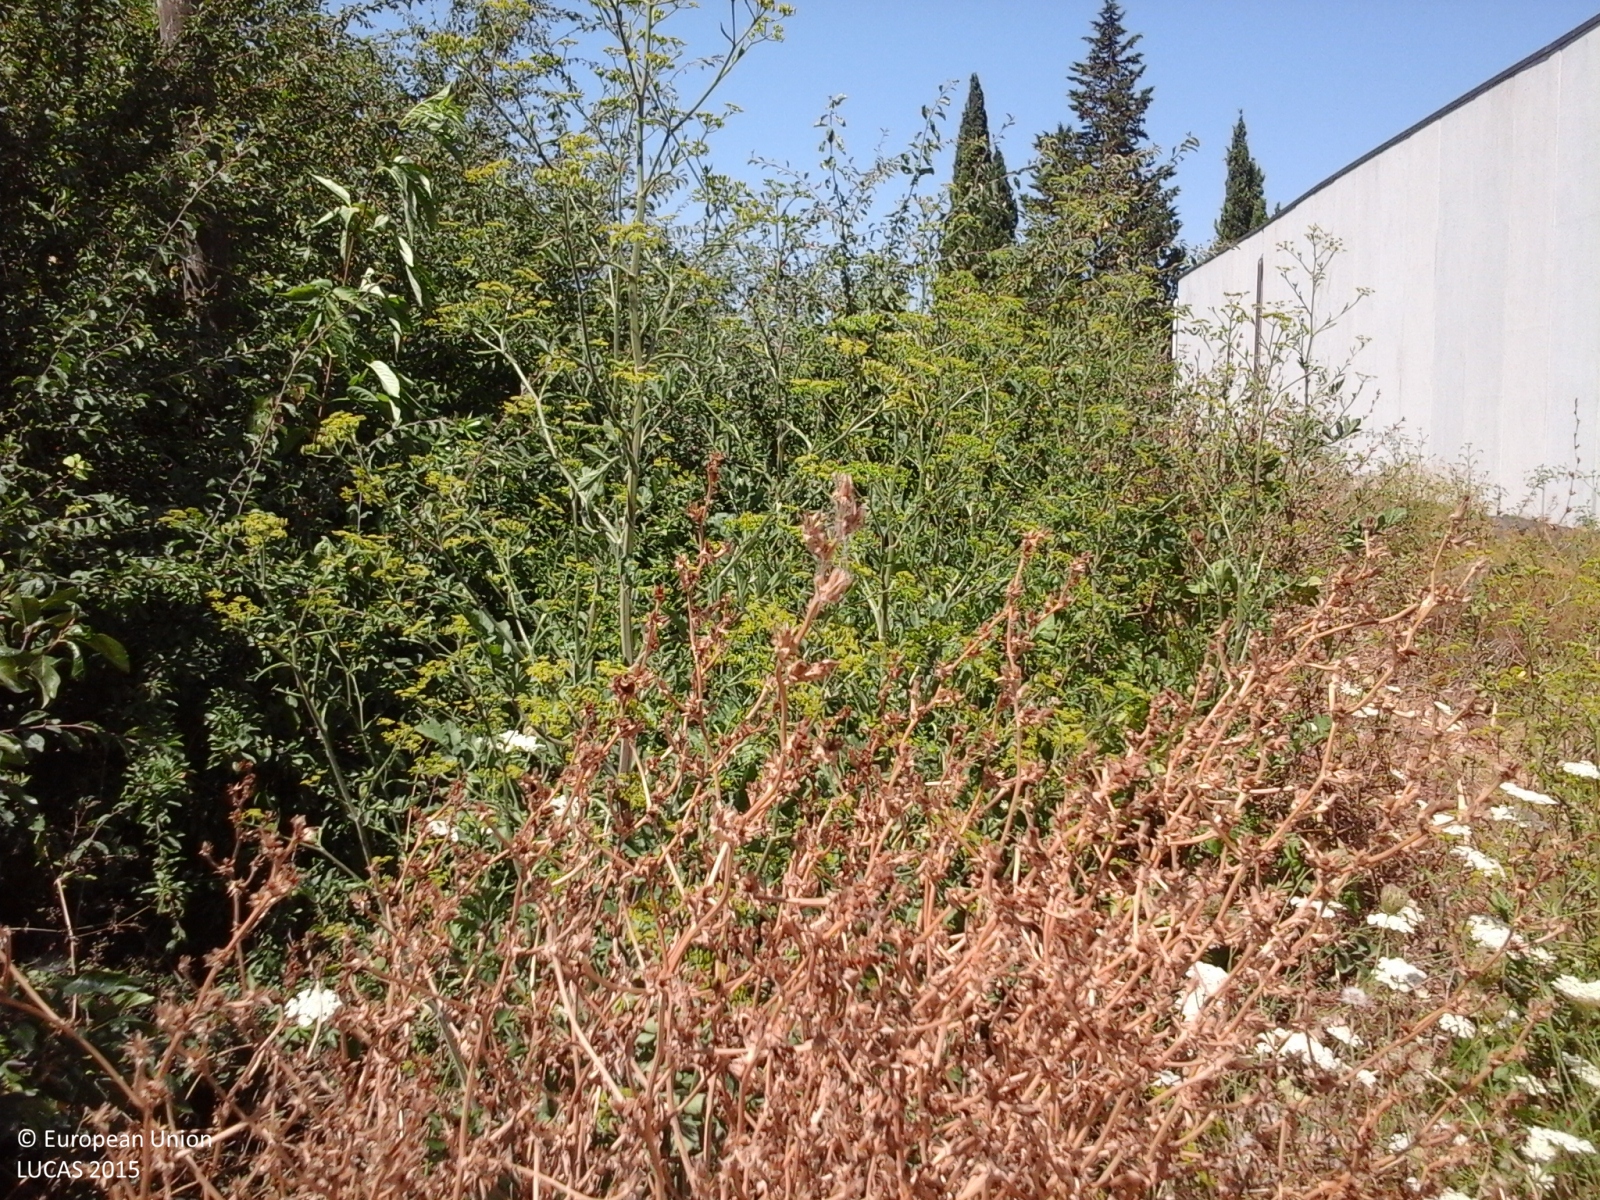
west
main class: Grassland
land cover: Grassland with sparse tree/shrub cover
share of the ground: > 75 %
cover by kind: herbaceous plants 95 %, broadleaved forest trees 5 %
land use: Community services
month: August
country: IT
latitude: 43.4597
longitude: 12.2557
